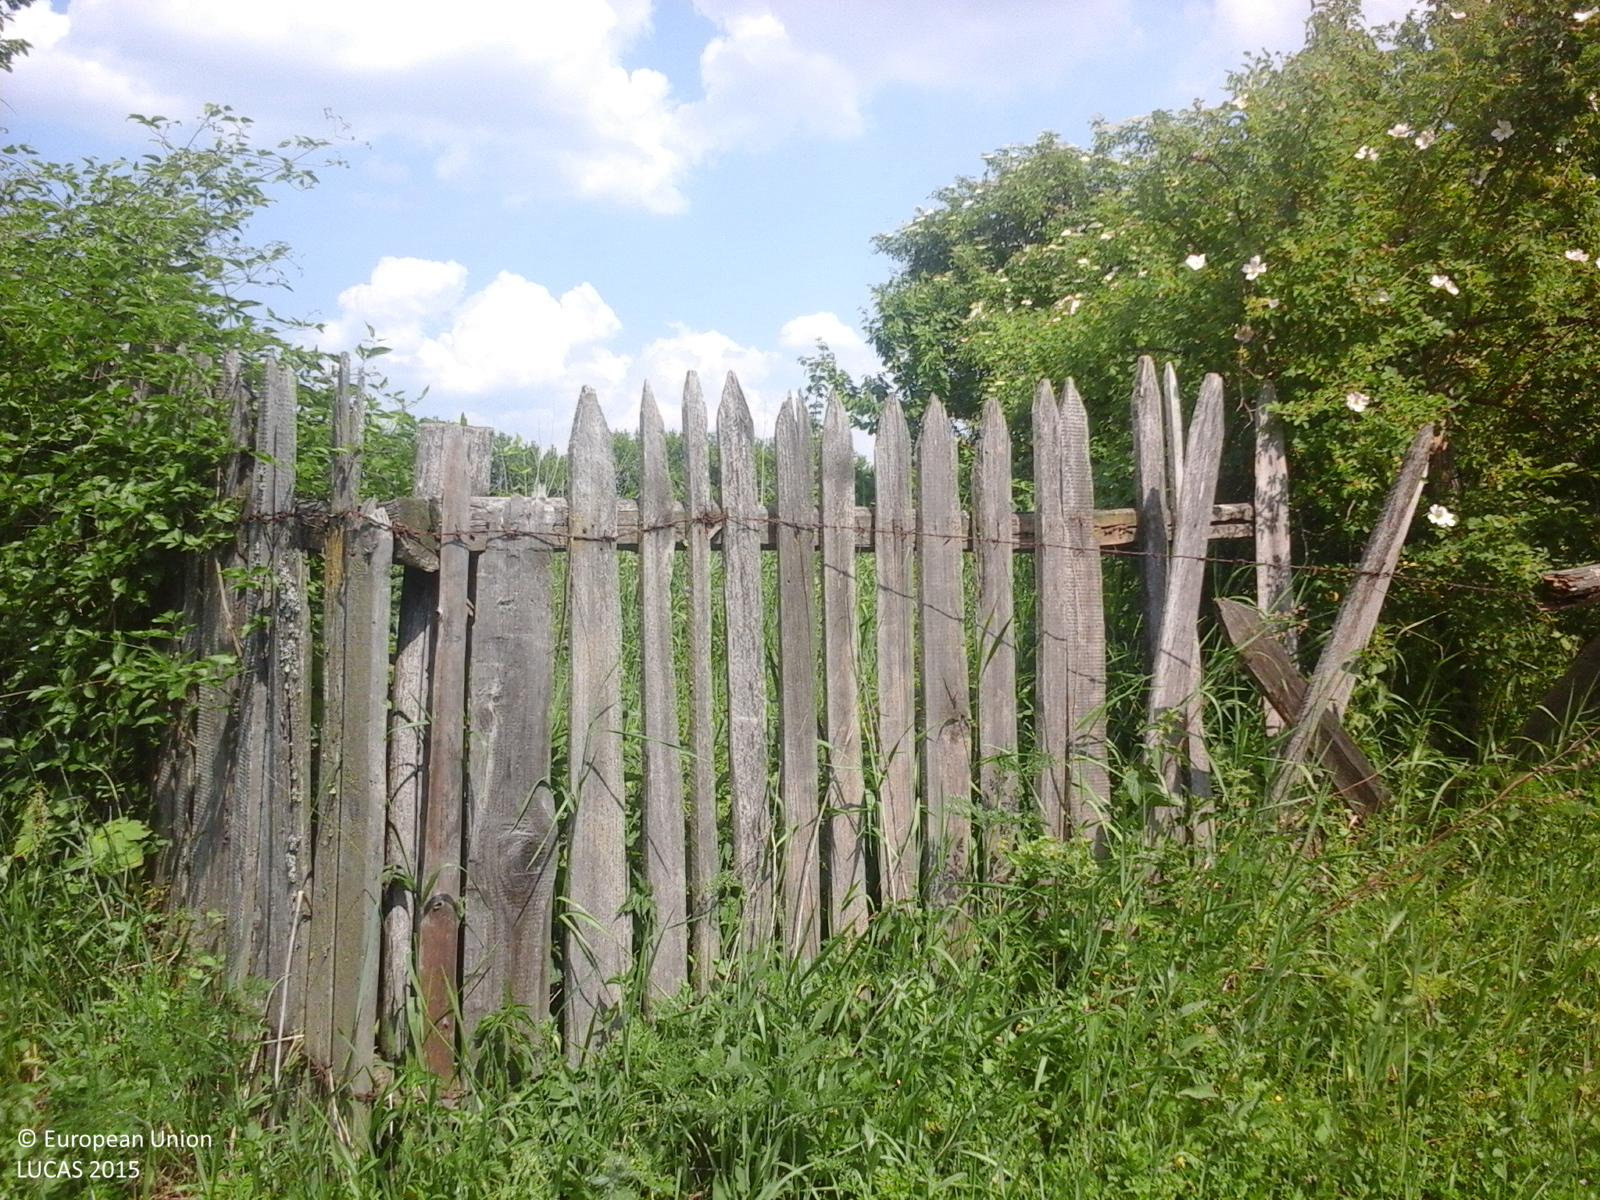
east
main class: Grassland
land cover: Grassland without tree/shrub cover
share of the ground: > 75 %
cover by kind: herbaceous plants 100 %
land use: Agriculture (excluding fallow land and kitchen gardens)
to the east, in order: Tracks; Grass margins; Fences; Grassland with sparse tree/shrub cover; Grassland without tree/shrub cover; Lines of trees; Grass margins; Tracks; Grassland without tree/shrub cover; Tracks; Grassland with sparse tree/shrub cover
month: June
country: RO
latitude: 46.7251
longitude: 26.5314
